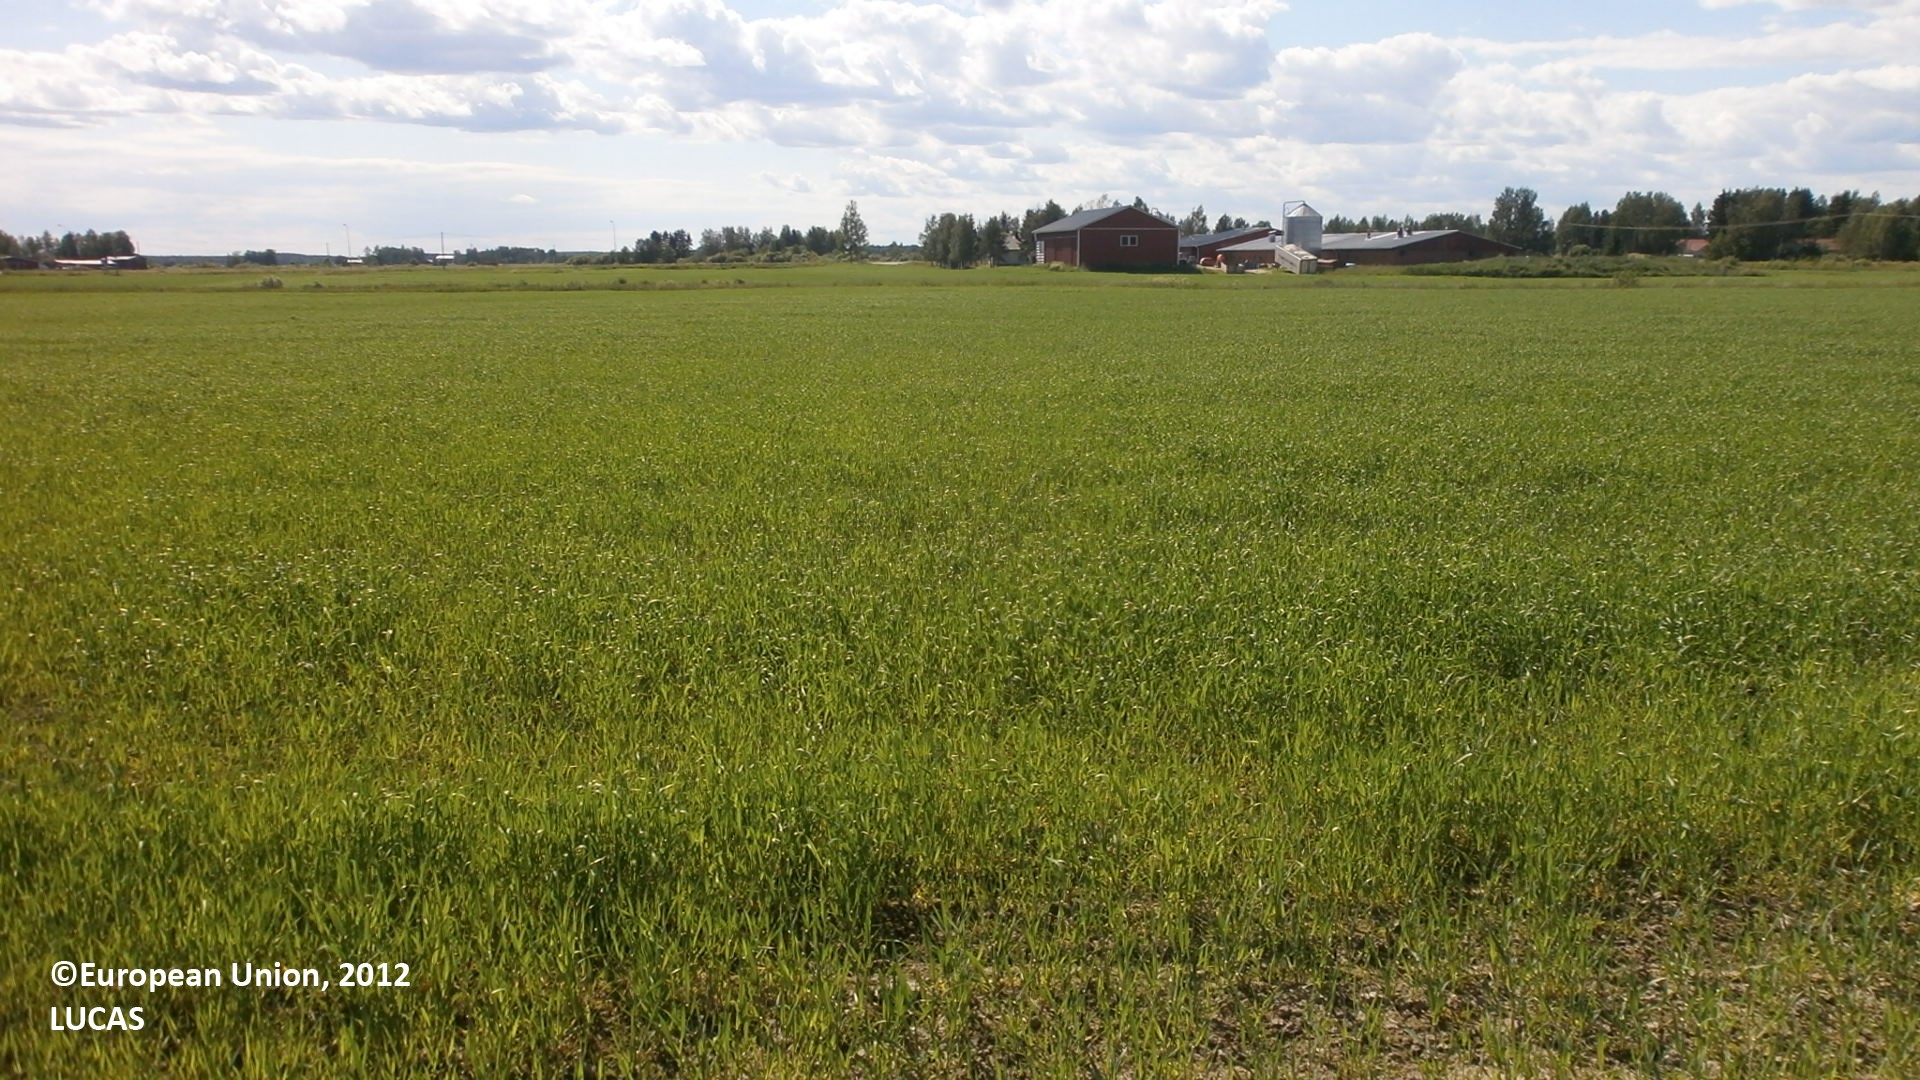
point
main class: Cropland
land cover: Barley
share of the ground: 25 - 50 %
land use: Agriculture (excluding fallow land and kitchen gardens)
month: July
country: FI
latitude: 63.9959
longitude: 24.7787
